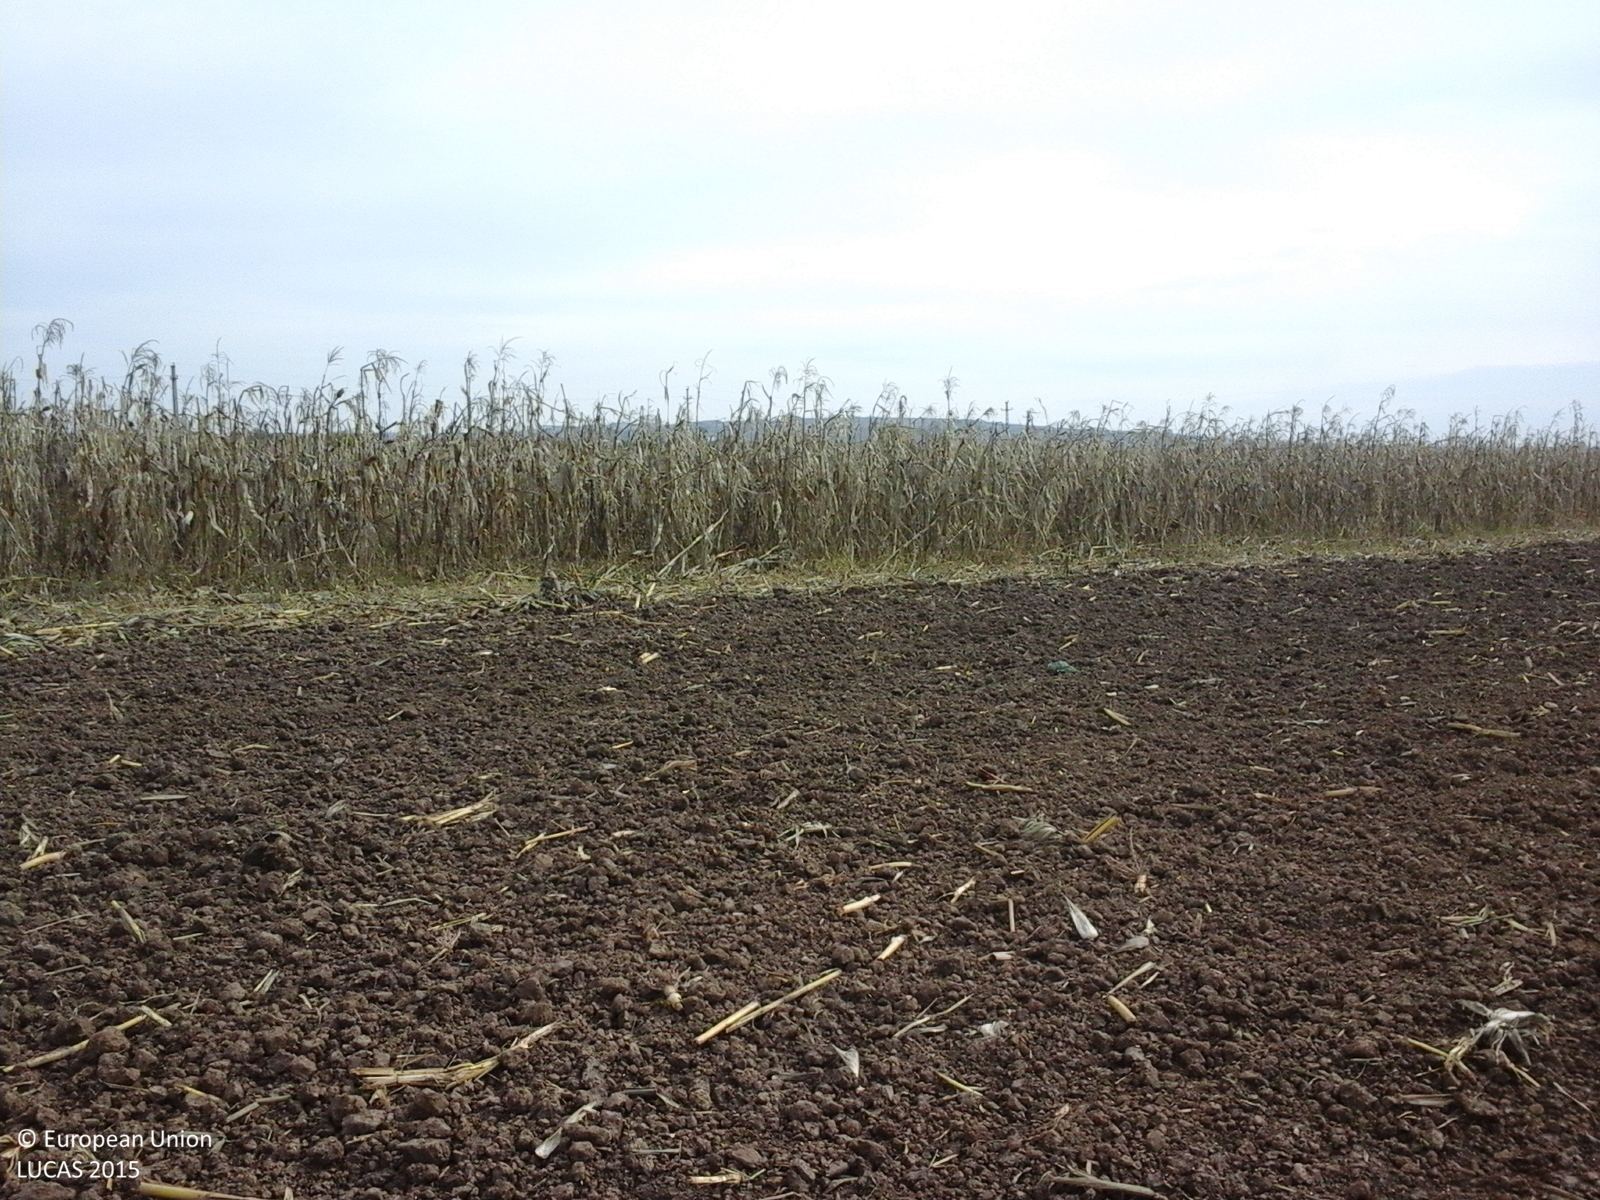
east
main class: Cropland
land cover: Maize
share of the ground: < 10 %
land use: Agriculture (excluding fallow land and kitchen gardens)
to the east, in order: Maize; Other bare soil; Common wheat; Maize; Spontaneously vegetated surfaces; Maize; Electric lines; Maize; Tracks; Spontaneously vegetated surfaces
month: October
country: RO
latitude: 44.9998
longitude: 26.0556
